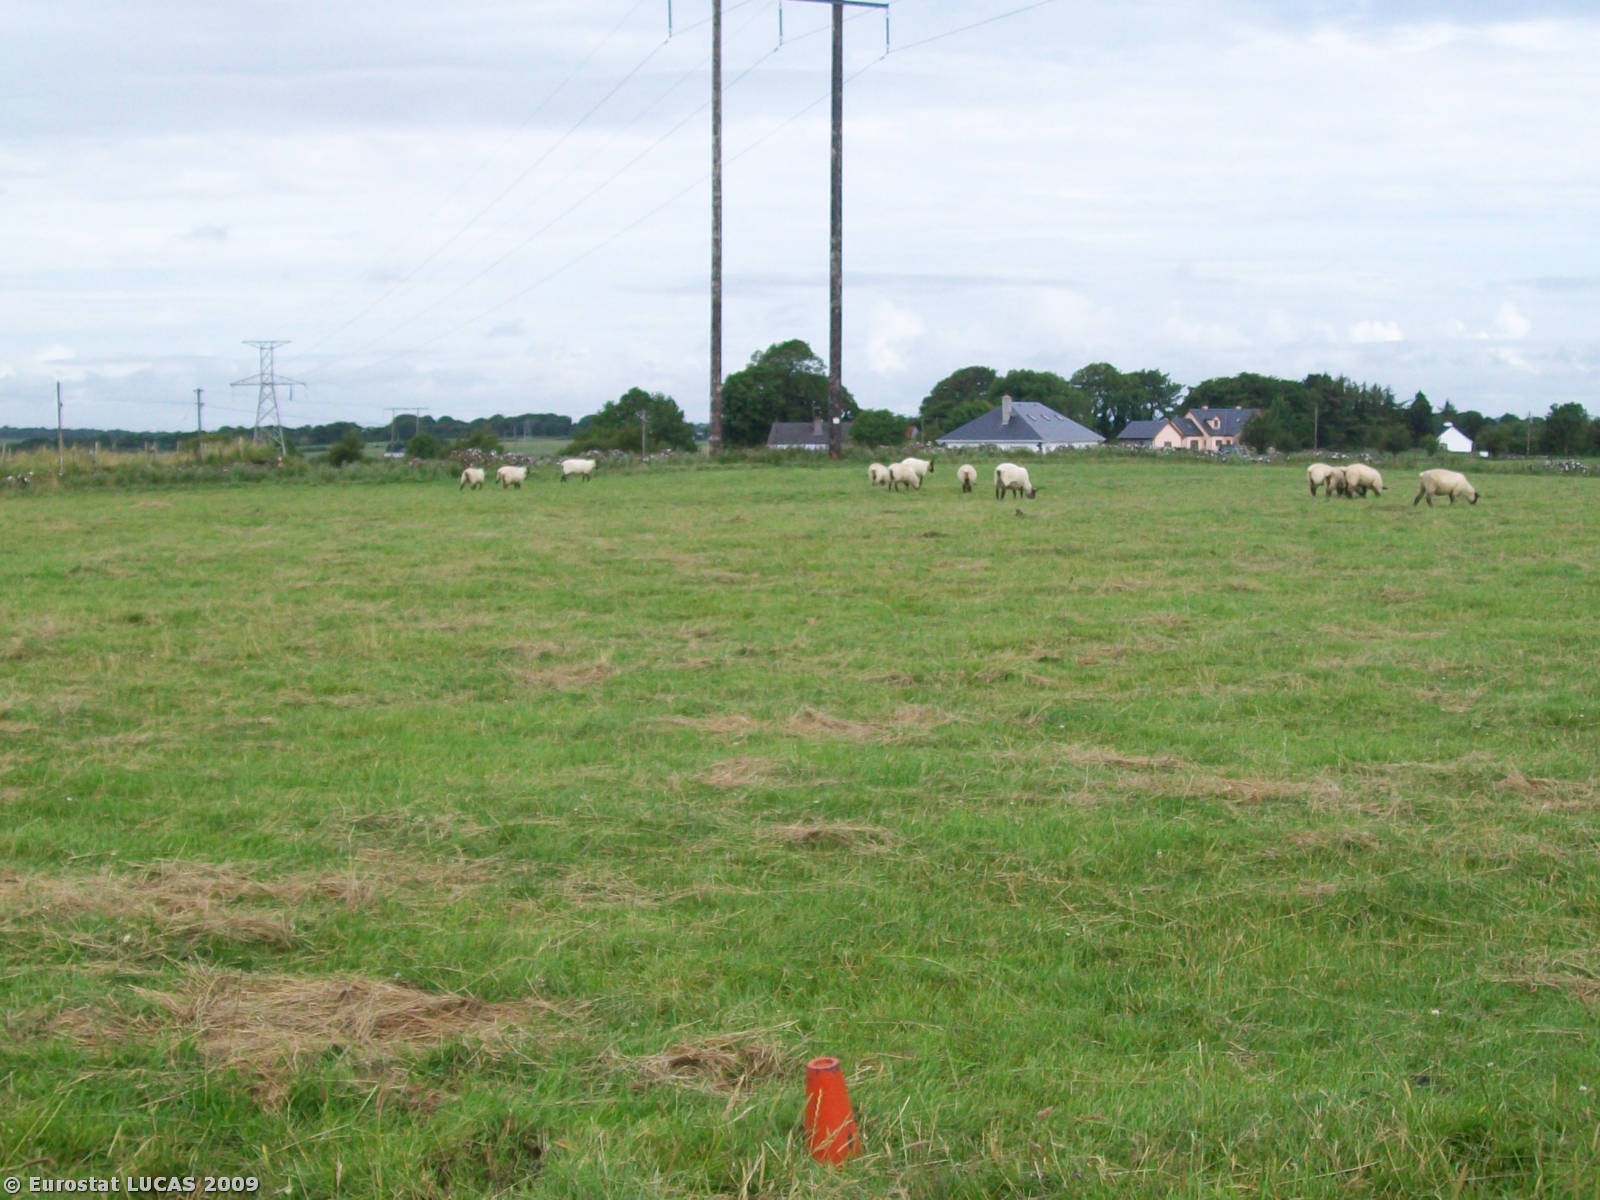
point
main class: Grassland
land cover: Grassland without tree/shrub cover
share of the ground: > 75 %
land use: Agriculture (excluding fallow land and kitchen gardens)
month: July
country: IE
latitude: 53.5046
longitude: -8.8885
